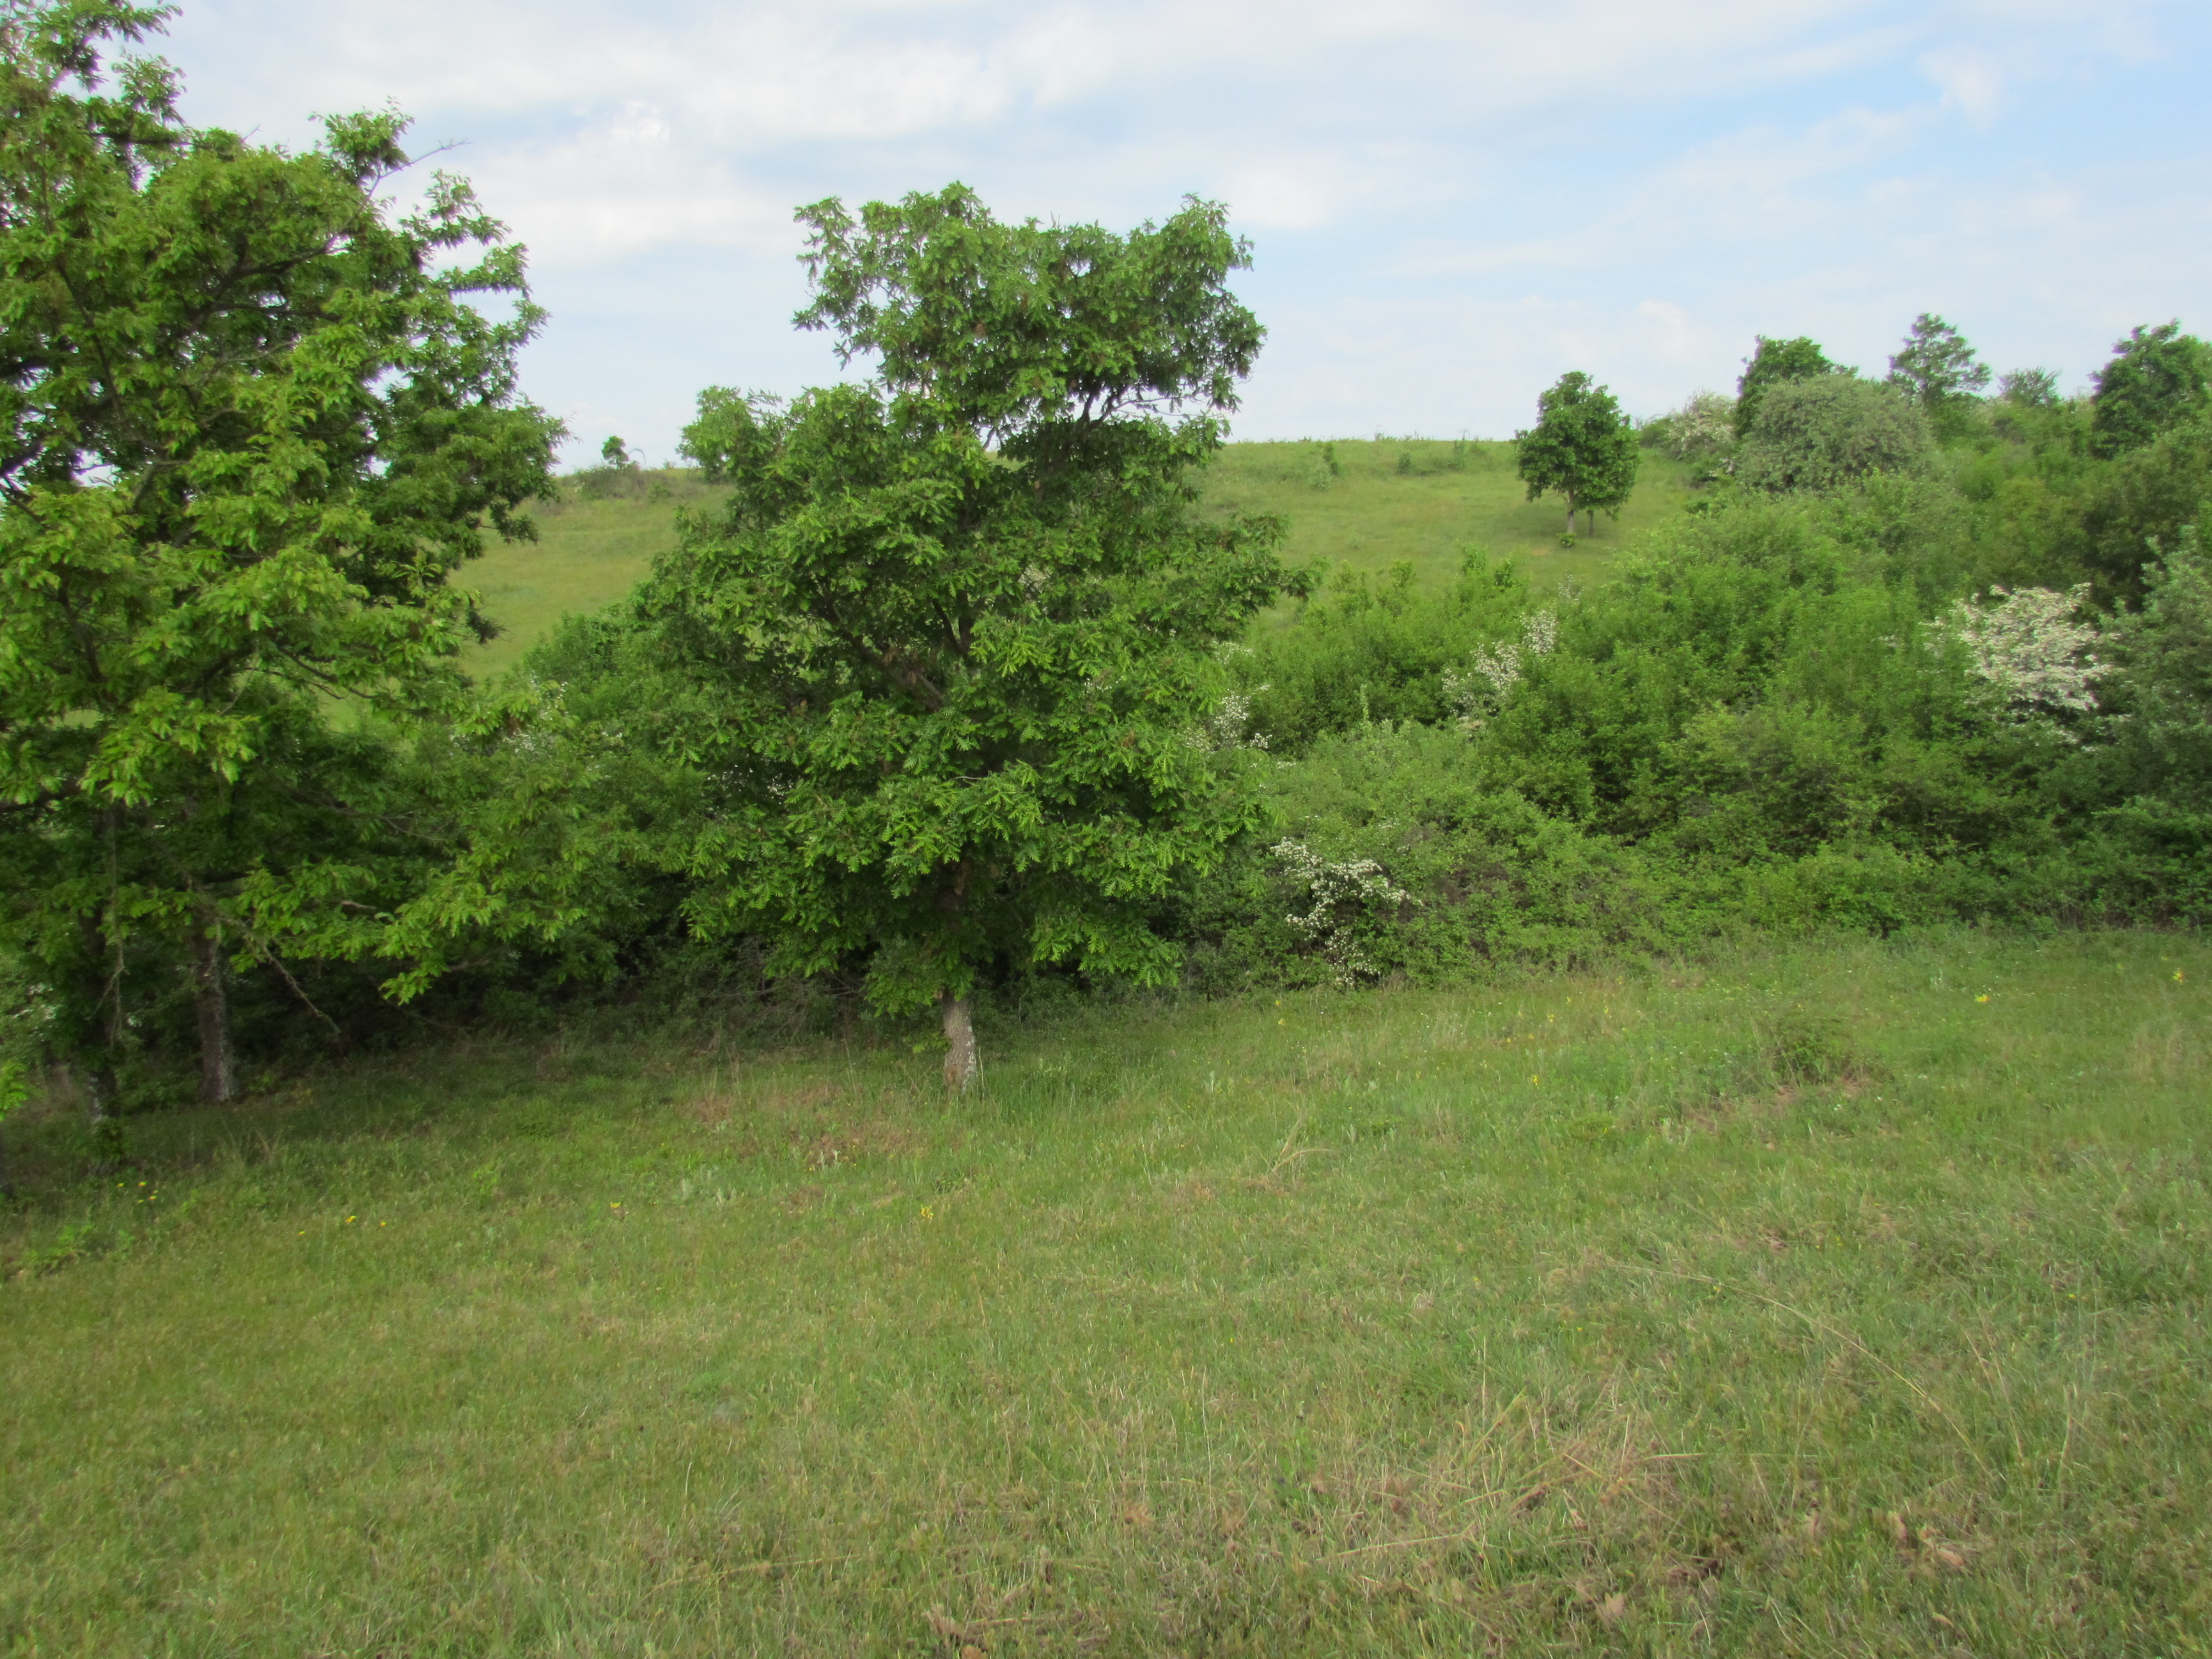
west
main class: Grassland
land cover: Grassland with sparse tree/shrub cover
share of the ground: > 75 %
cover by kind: herbaceous plants 90 %, broadleaved forest trees 5 %, shrubs 5 %
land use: Agriculture (excluding fallow land and kitchen gardens)
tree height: > 5 m
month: May
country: BG
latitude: 42.2630
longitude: 27.1624
